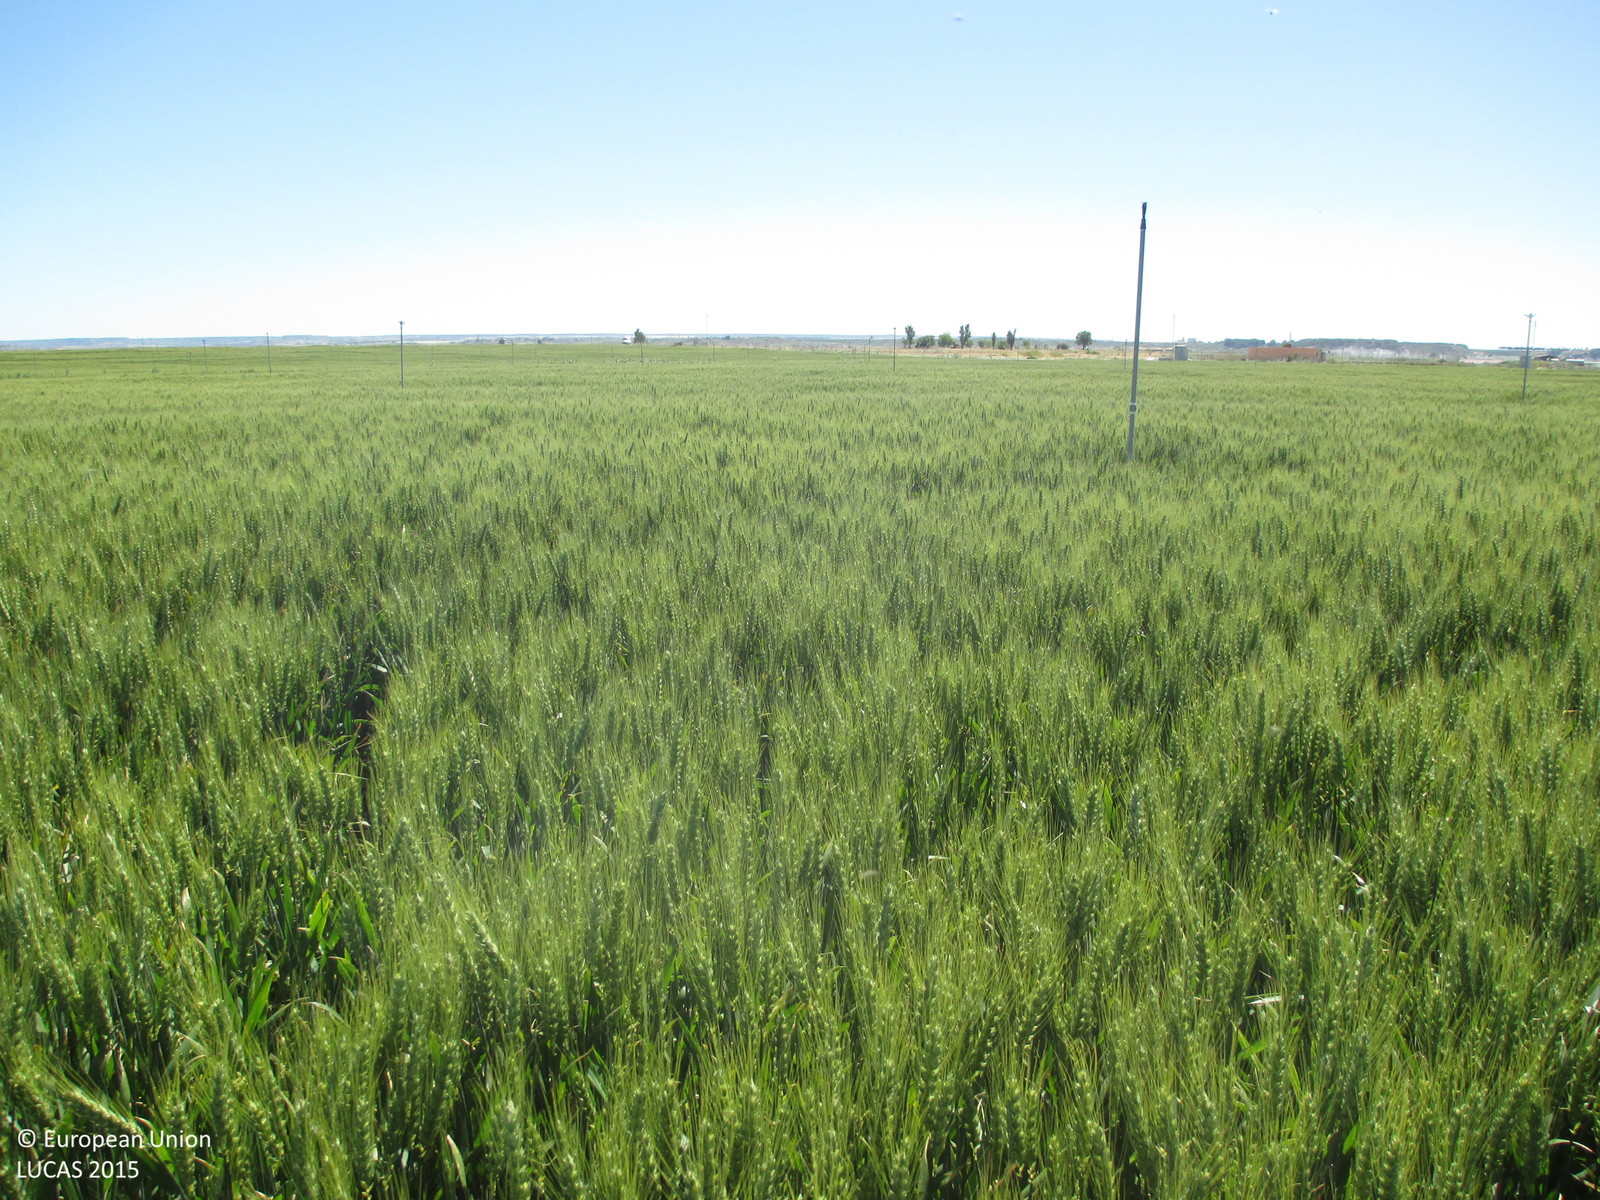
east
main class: Cropland
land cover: Durum wheat
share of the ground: > 75 %
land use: Agriculture (excluding fallow land and kitchen gardens)
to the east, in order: Durum wheat
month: May
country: ES
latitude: 41.8422
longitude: -0.2435
